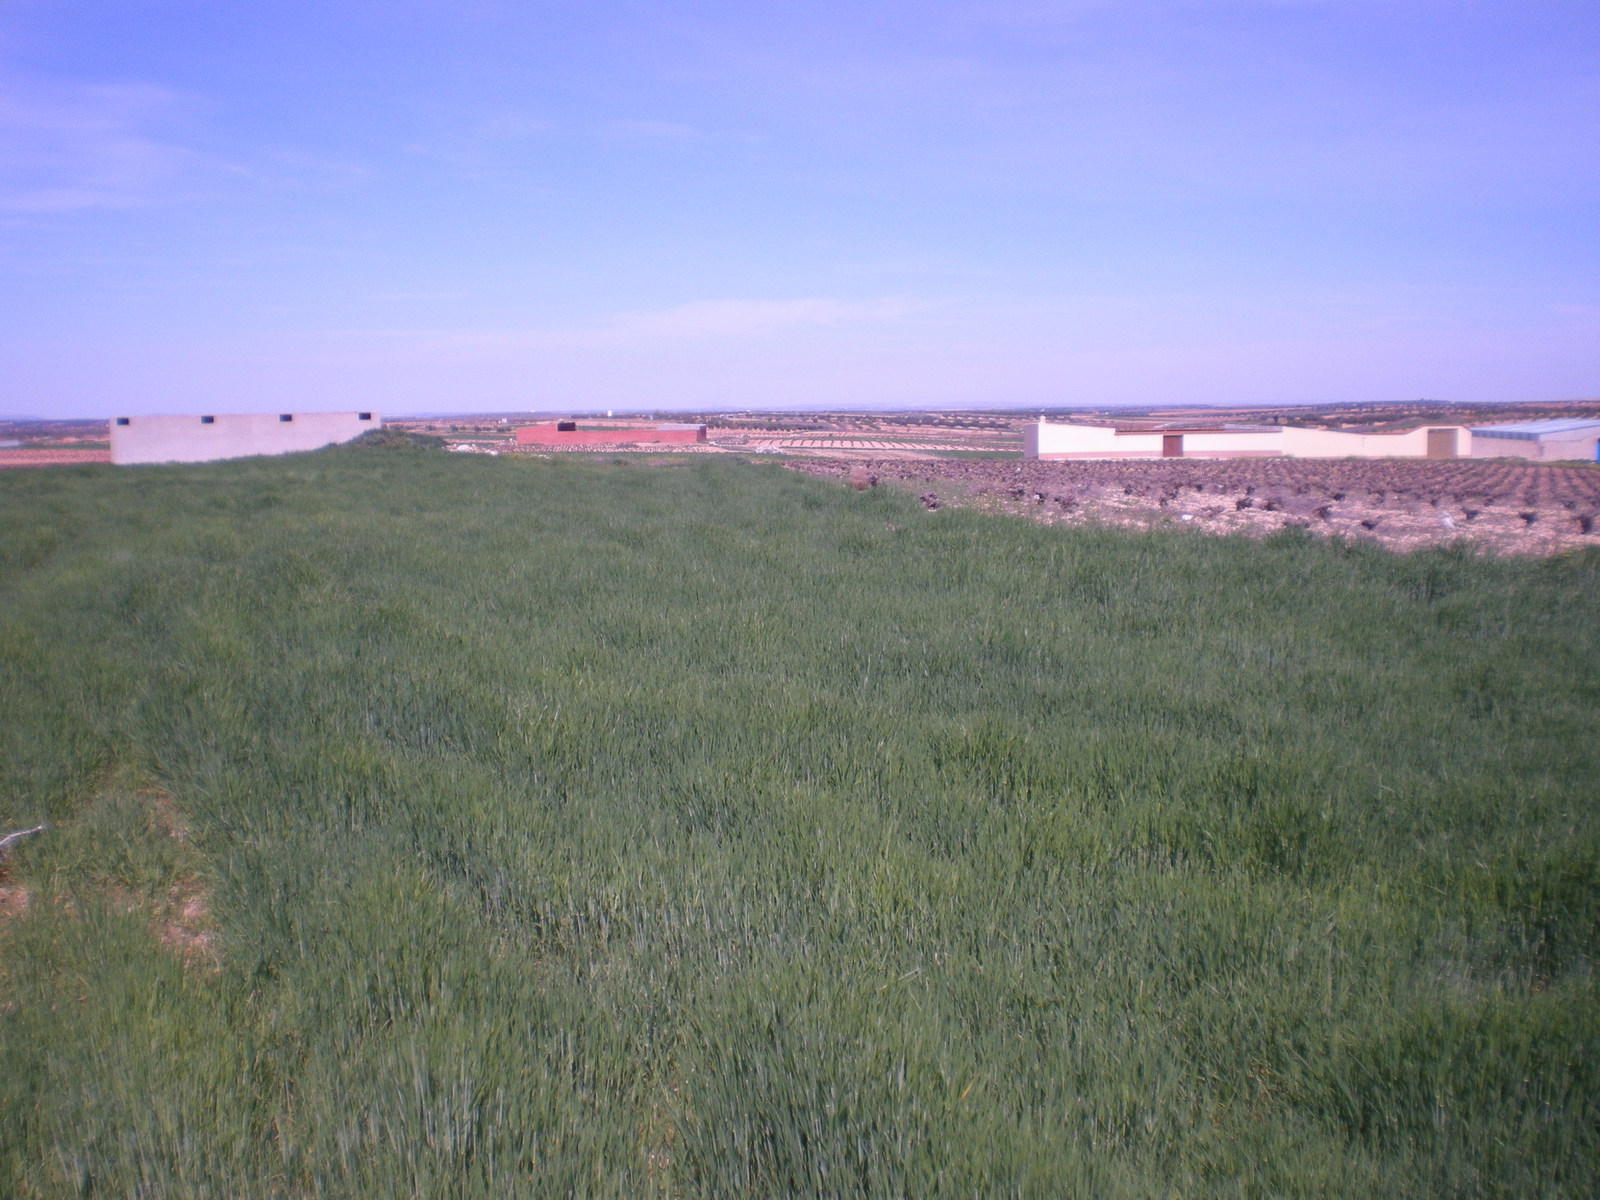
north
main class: Cropland
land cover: Barley
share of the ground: > 75 %
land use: Agriculture (excluding fallow land and kitchen gardens)
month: March
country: ES
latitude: 38.9468
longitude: -3.2230
